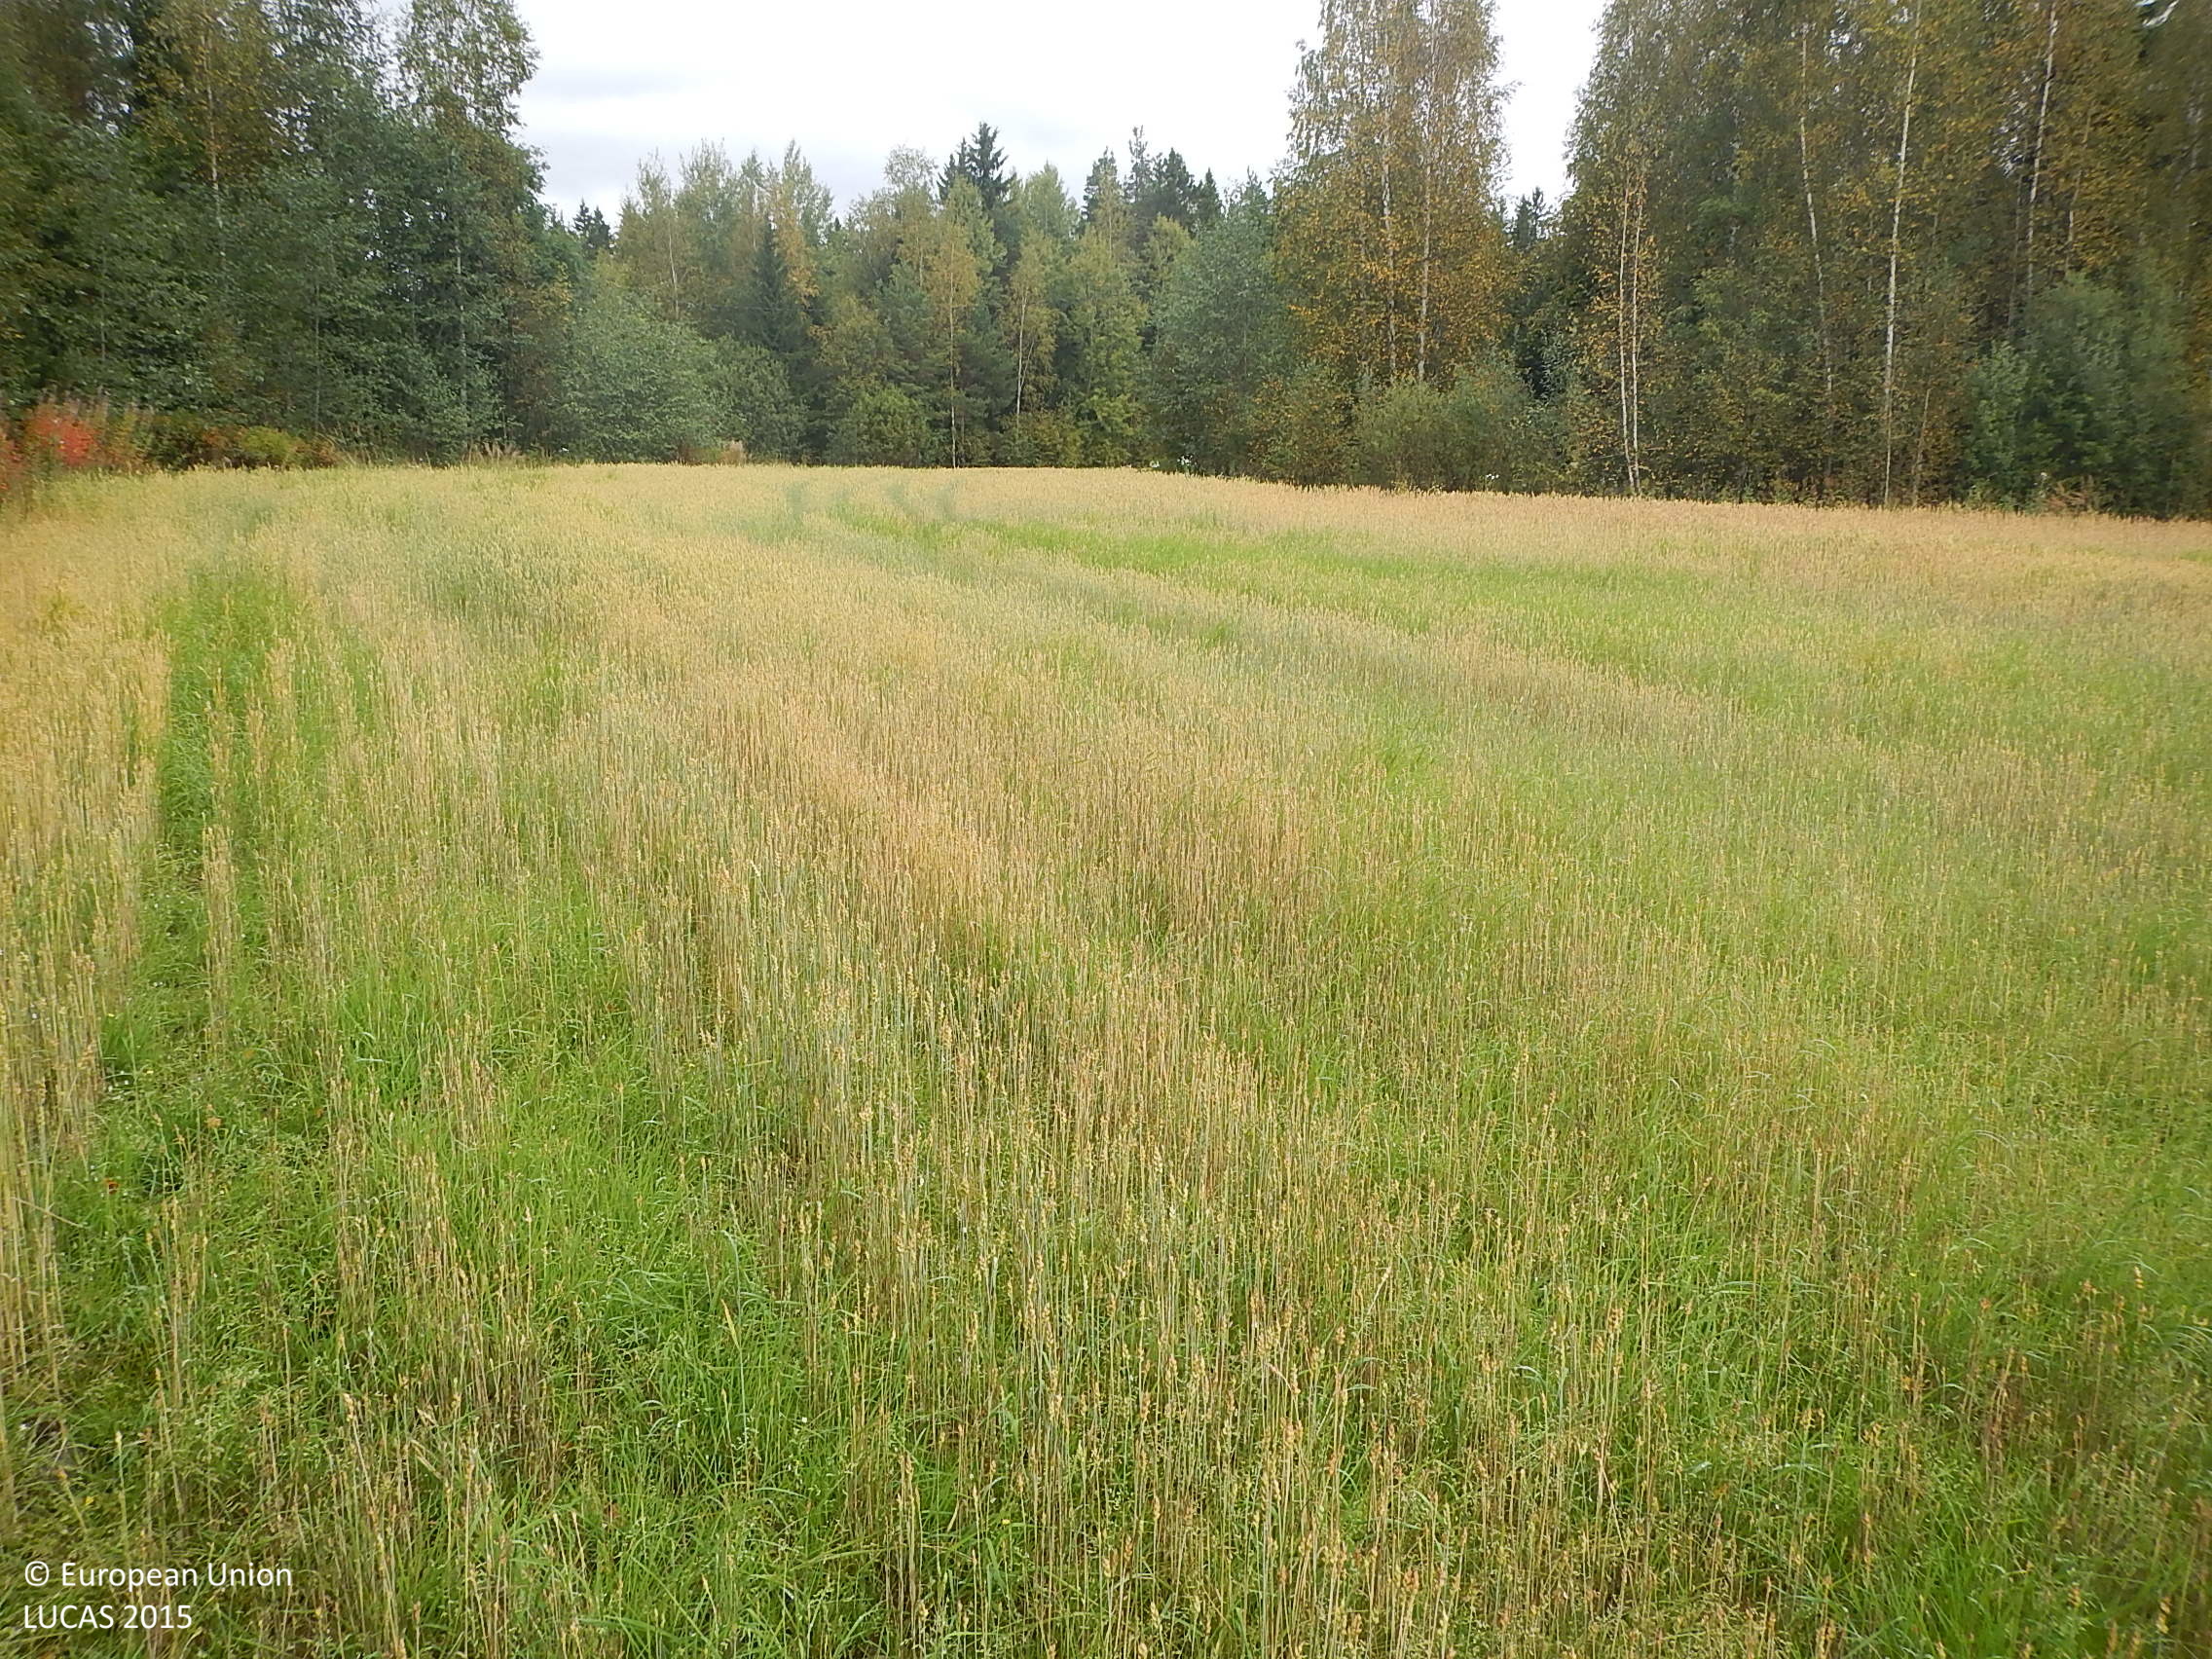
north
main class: Cropland
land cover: Common wheat
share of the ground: 25 - 50 %
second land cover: Spontaneously vegetated surfaces
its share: 50 - 75 %
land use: Agriculture (excluding fallow land and kitchen gardens)
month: September
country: FI
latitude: 61.4860
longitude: 22.7044
